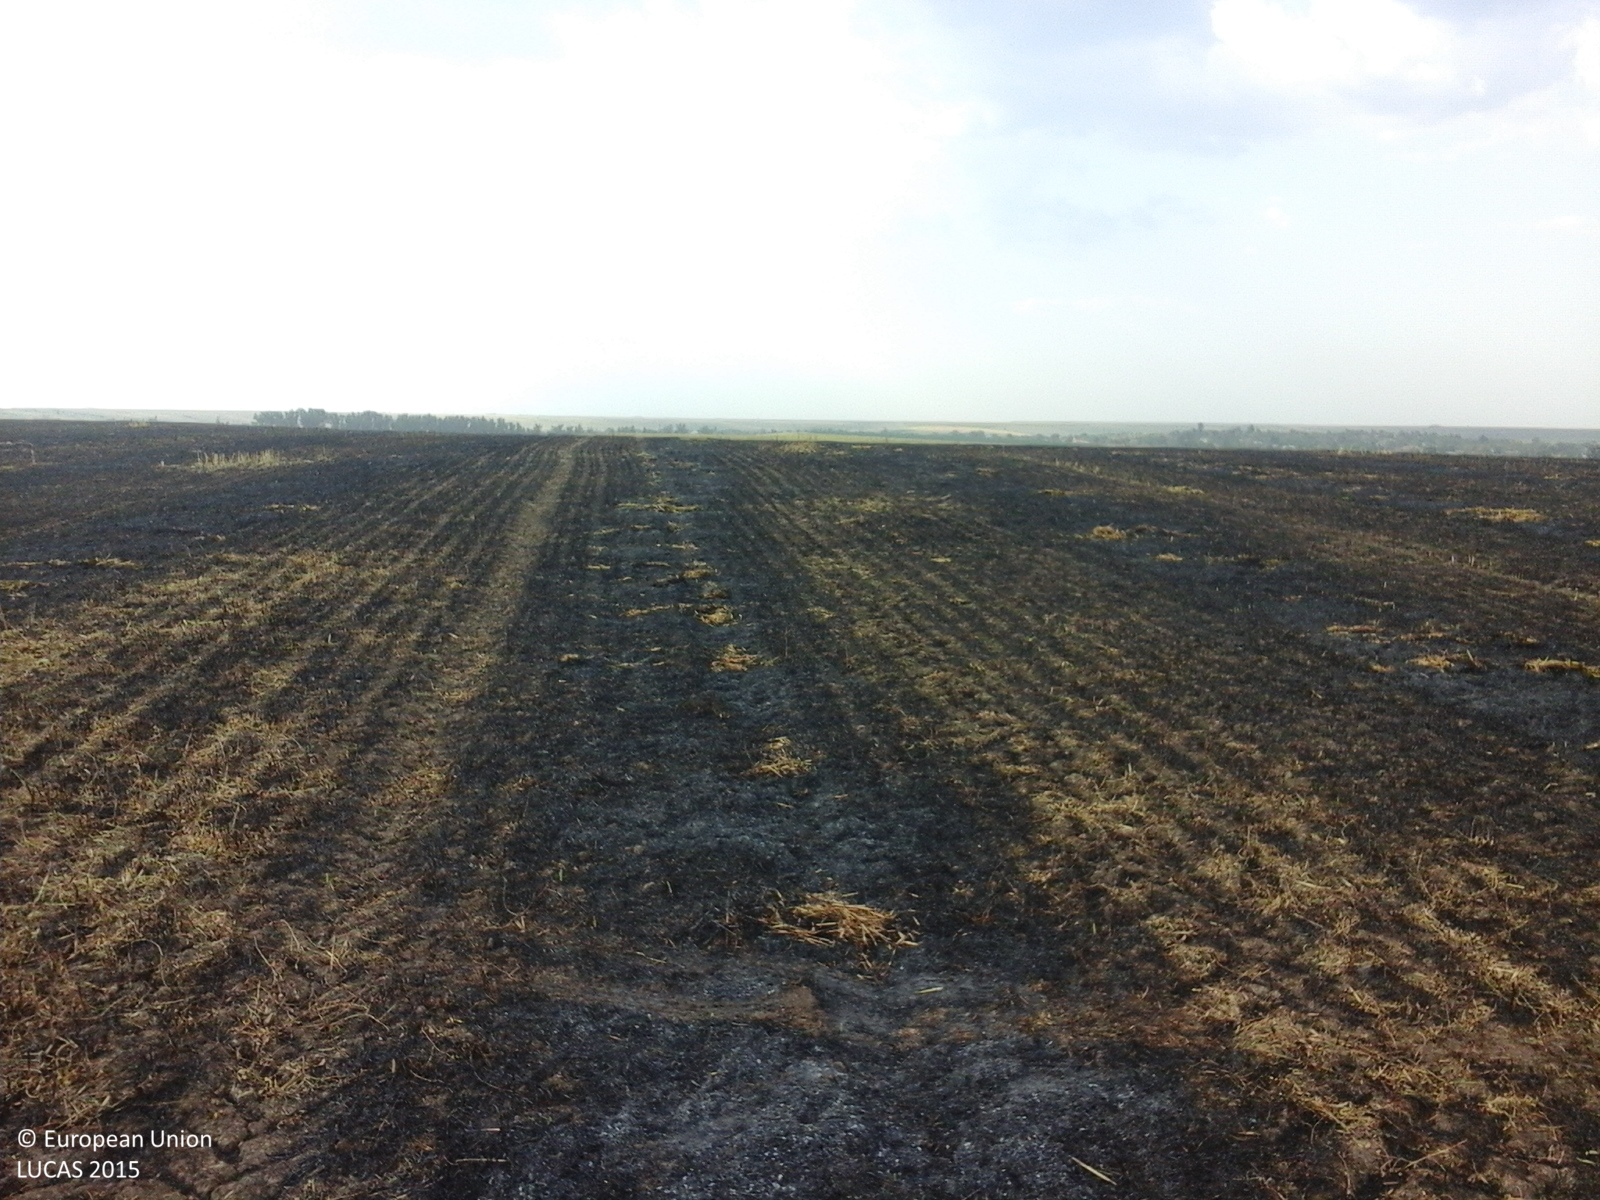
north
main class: Cropland
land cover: Common wheat
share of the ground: < 10 %
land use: Agriculture (excluding fallow land and kitchen gardens)
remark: Burnt area
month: July
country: RO
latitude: 43.9507
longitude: 24.8637
